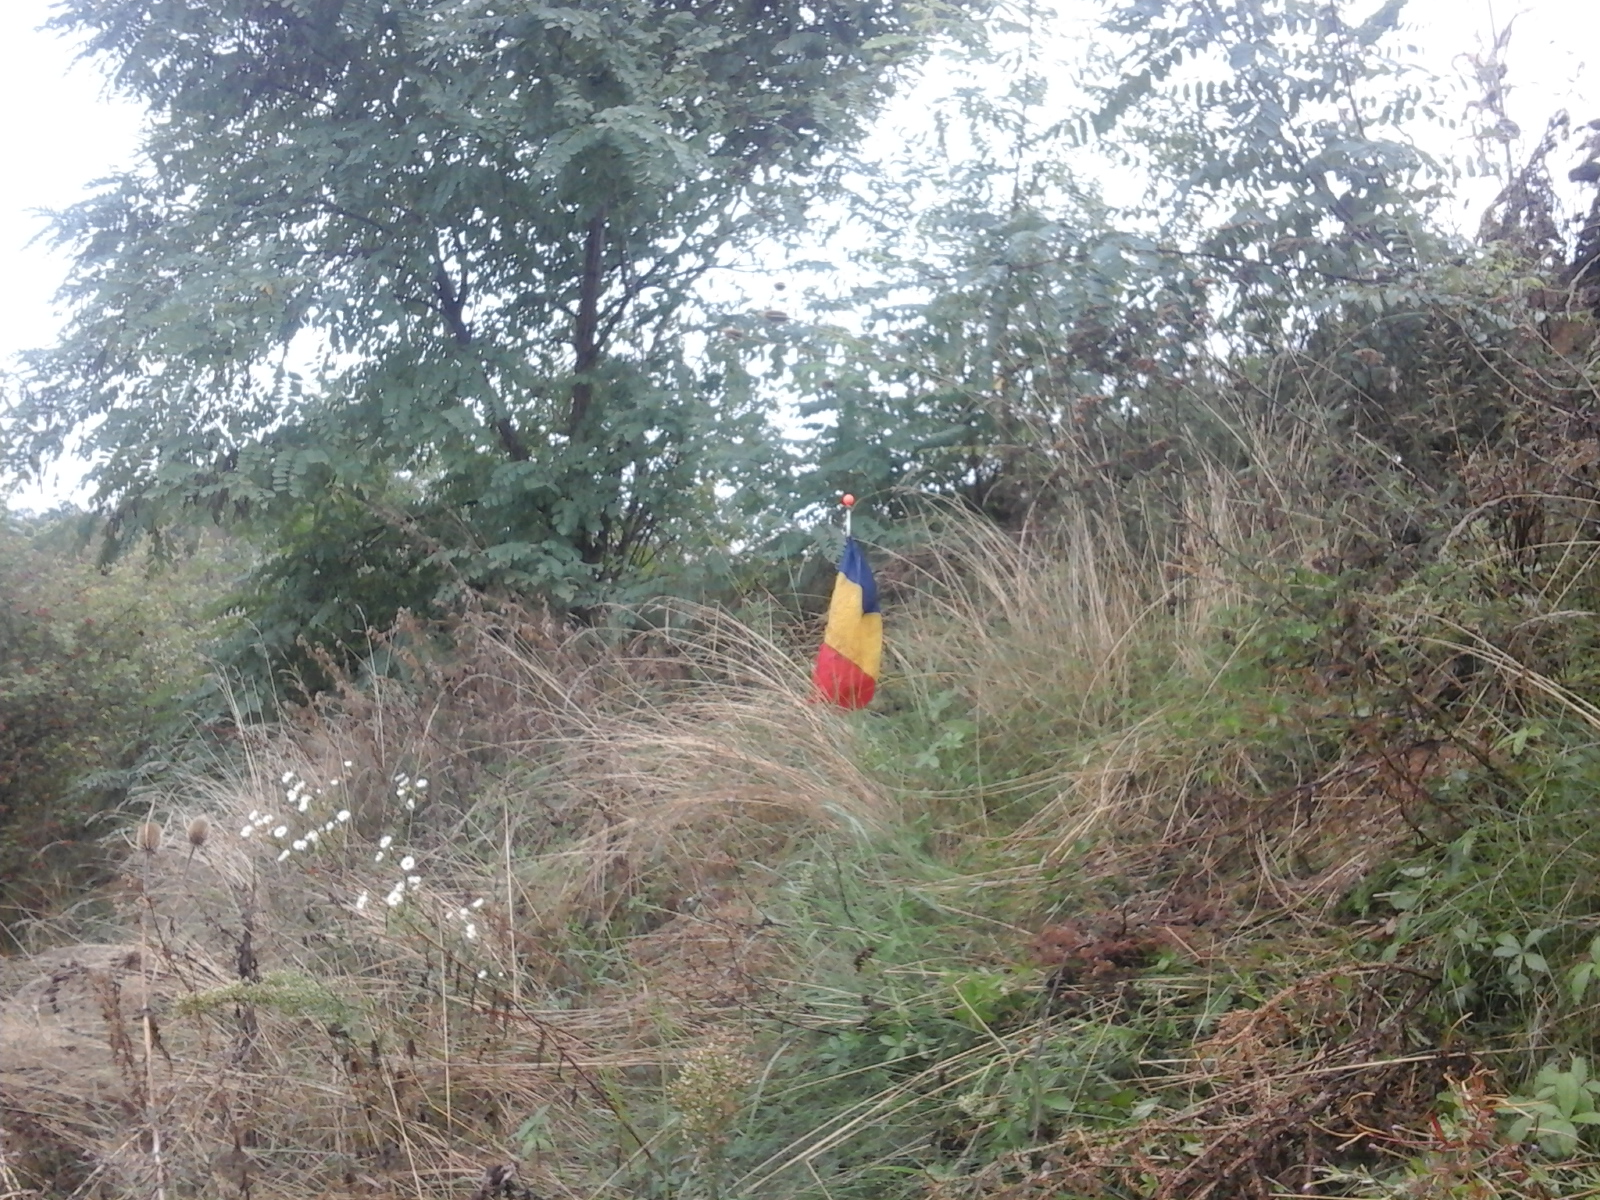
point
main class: Shrubland
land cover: Shrubland with sparse tree cover
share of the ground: > 75 %
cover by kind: shrubs 95 %, broadleaved forest trees 5 %
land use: Fallow land
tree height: < 5 m
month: September
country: RO
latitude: 47.2313
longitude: 22.5378
